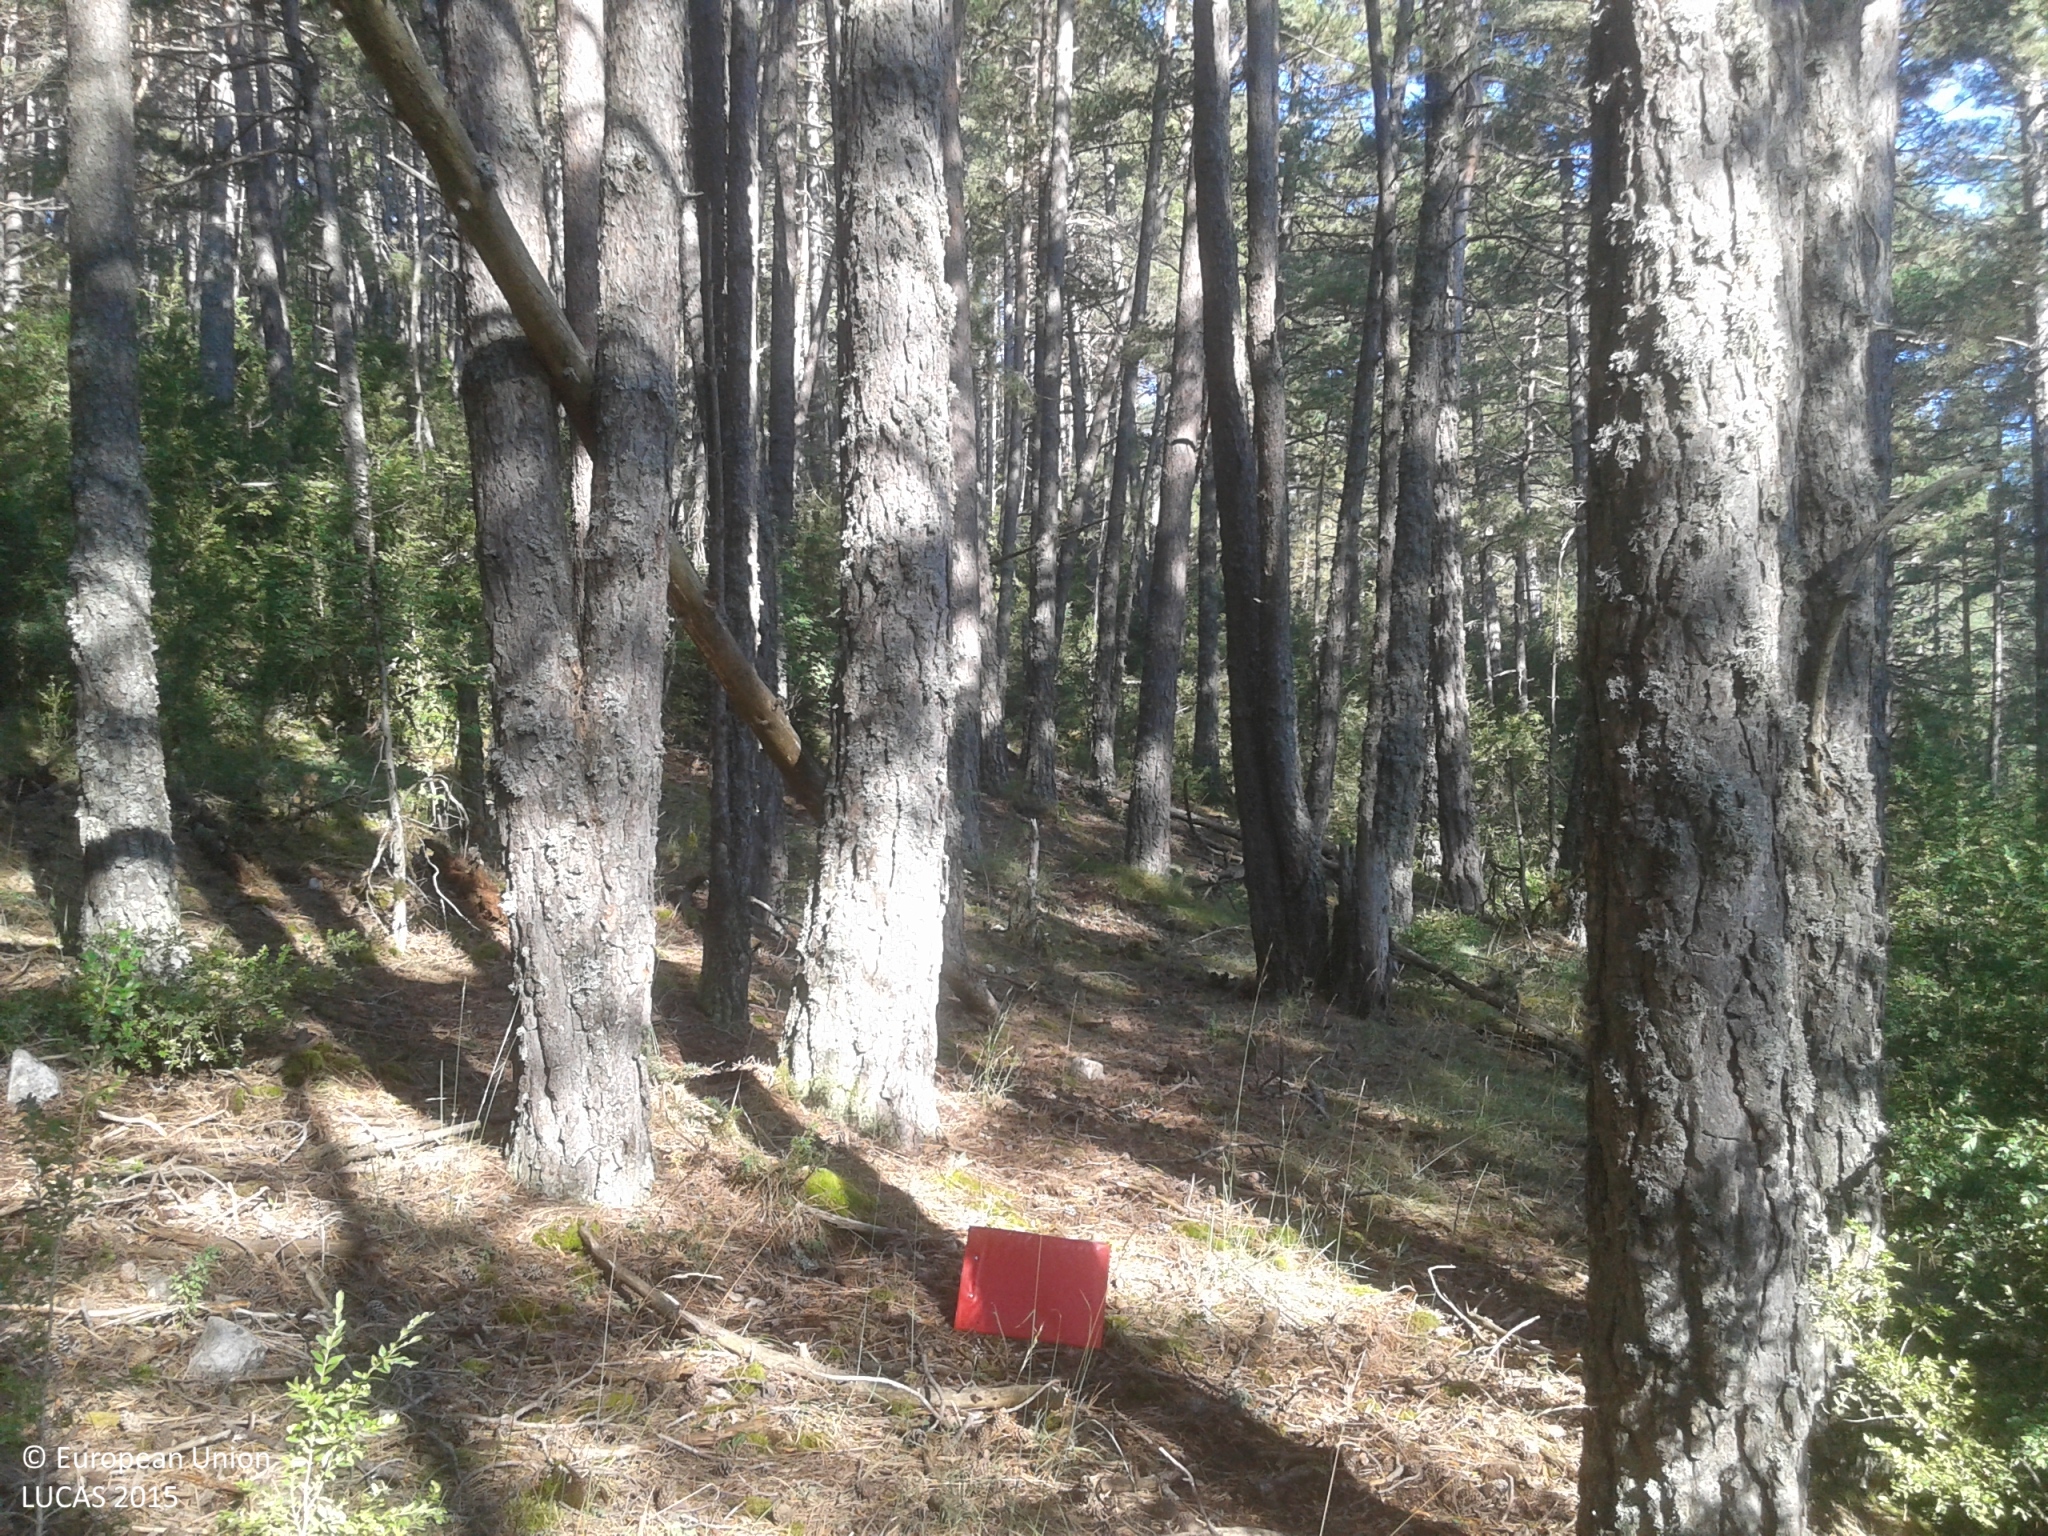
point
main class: Woodland
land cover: Pine dominated coniferous woodland
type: alpine coniferous forest
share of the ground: > 75 %
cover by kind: coniferous forest trees 95 %, shrubs 5 %
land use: Forestry
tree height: > 5 m
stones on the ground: 25 - 50 %
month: July
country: ES
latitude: 42.2271
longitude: 1.5421
